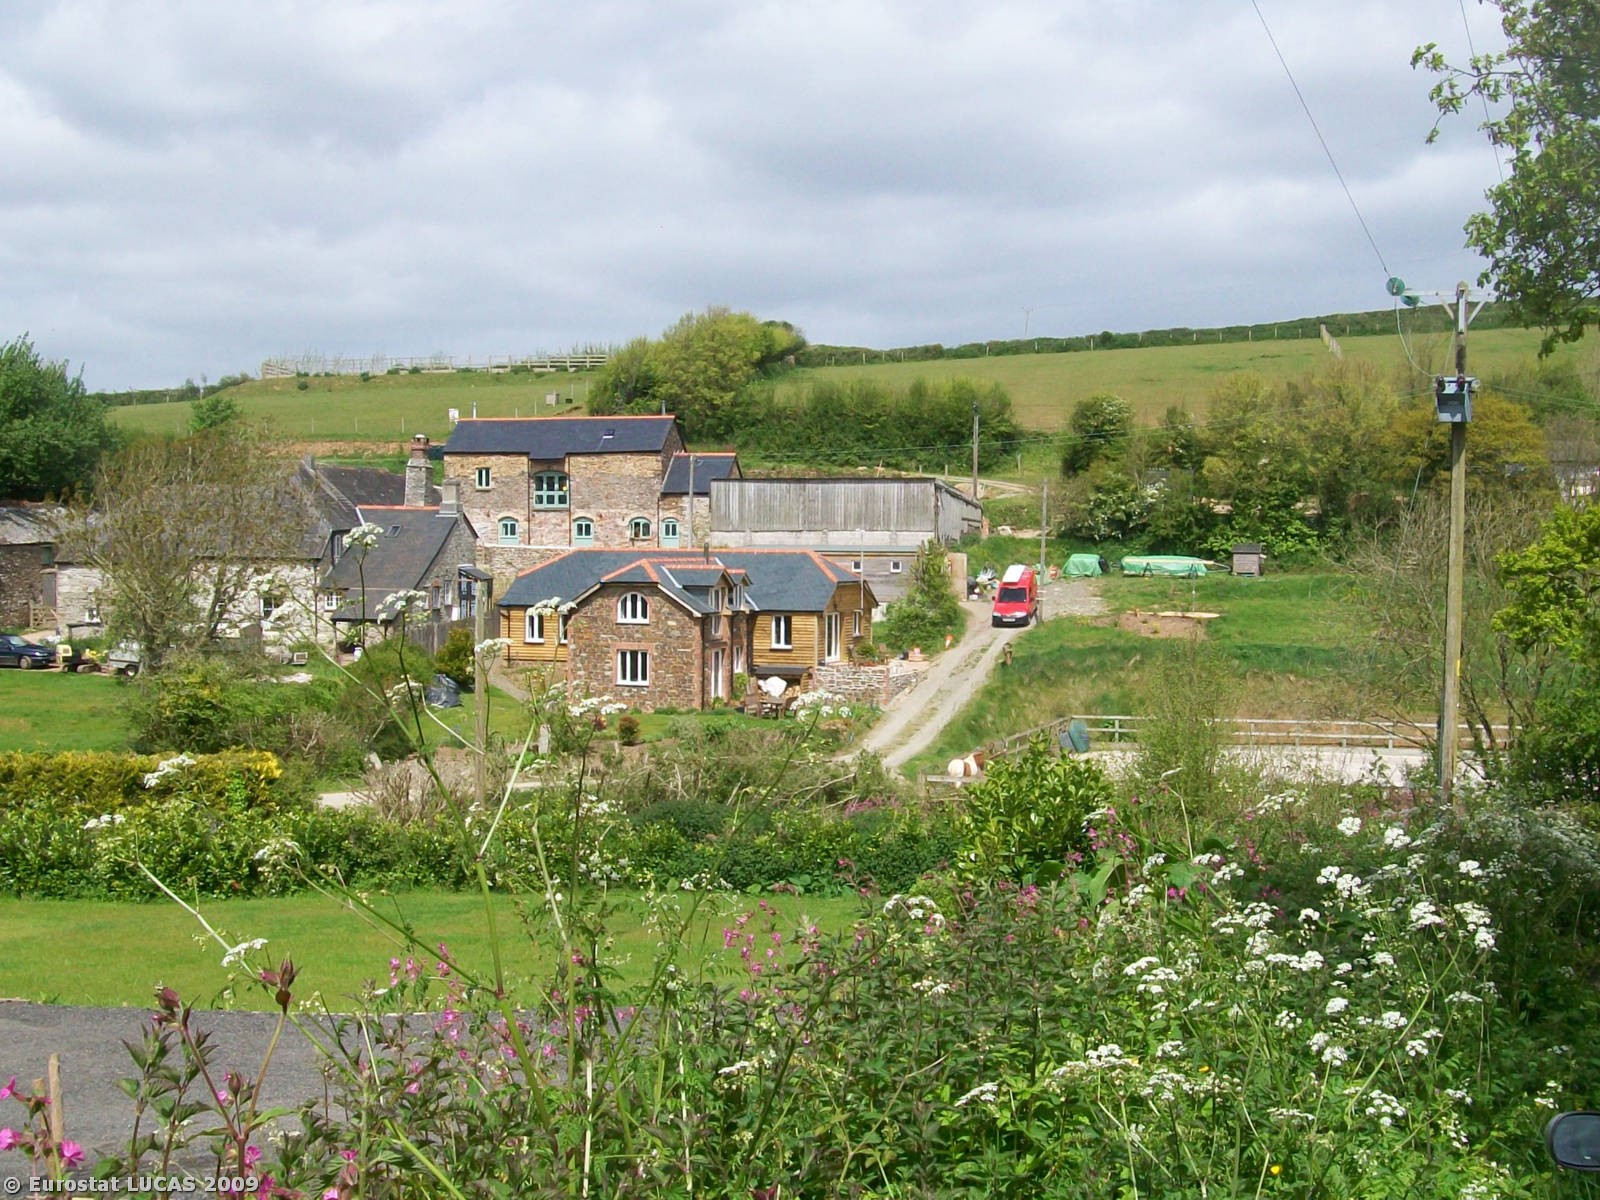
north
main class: Woodland
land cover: Broadleaved woodland
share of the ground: > 75 %
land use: Unused
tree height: > 5 m
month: May
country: GB
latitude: 50.3604
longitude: -4.2540
